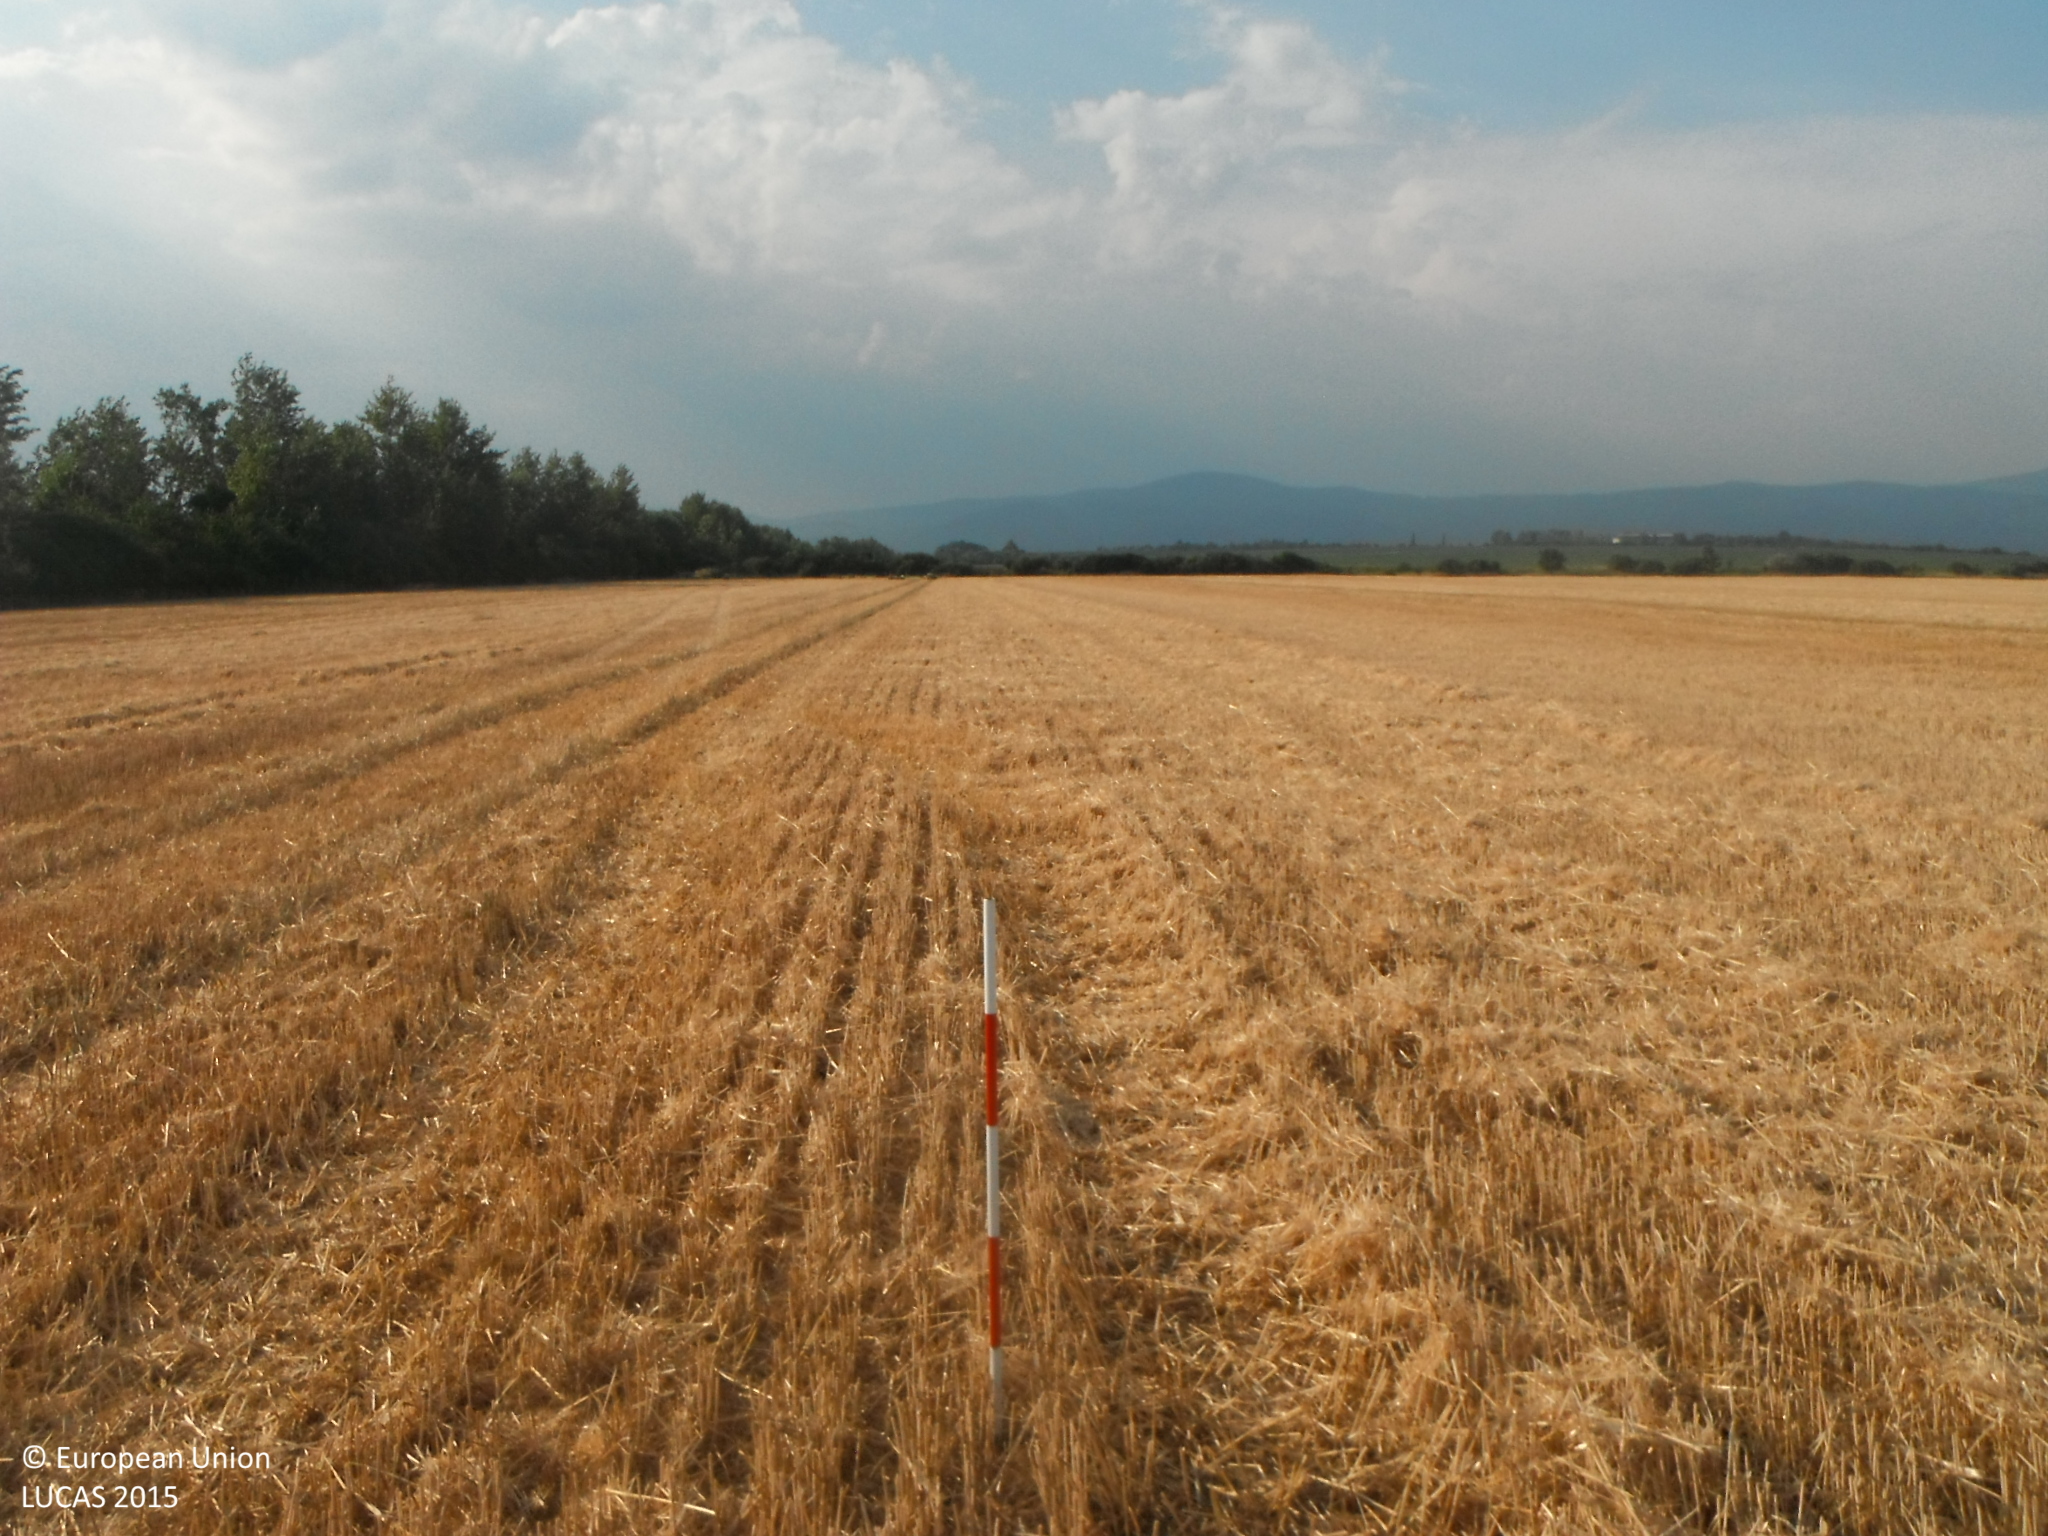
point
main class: Cropland
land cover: Common wheat
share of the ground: > 75 %
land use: Agriculture (excluding fallow land and kitchen gardens)
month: July
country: SK
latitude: 48.7437
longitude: 22.0361
